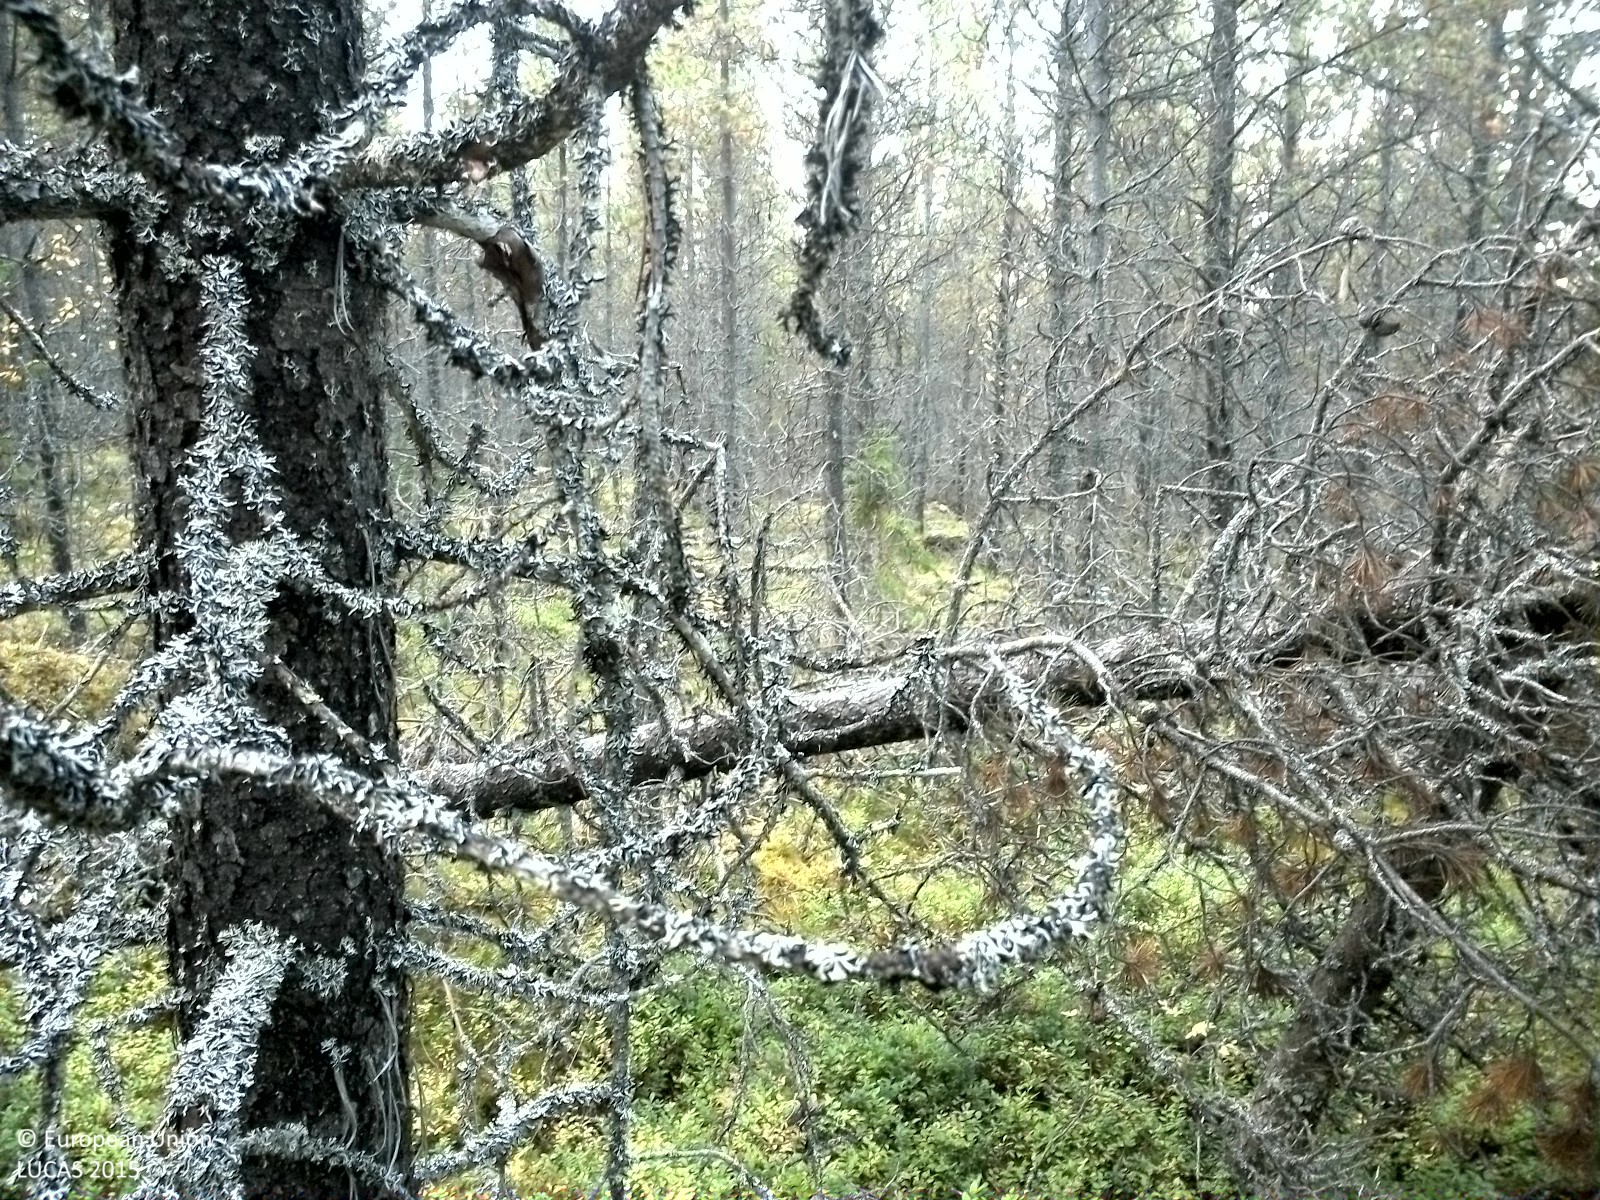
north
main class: Woodland
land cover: Pine dominated coniferous woodland
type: exotic forest
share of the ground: > 75 %
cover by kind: coniferous forest trees 75 %, shrubs 15 %, herbaceous plants 5 %, lichens and mosses 5 %
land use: Forestry
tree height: > 5 m
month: September
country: SE
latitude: 62.2379
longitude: 16.0423
